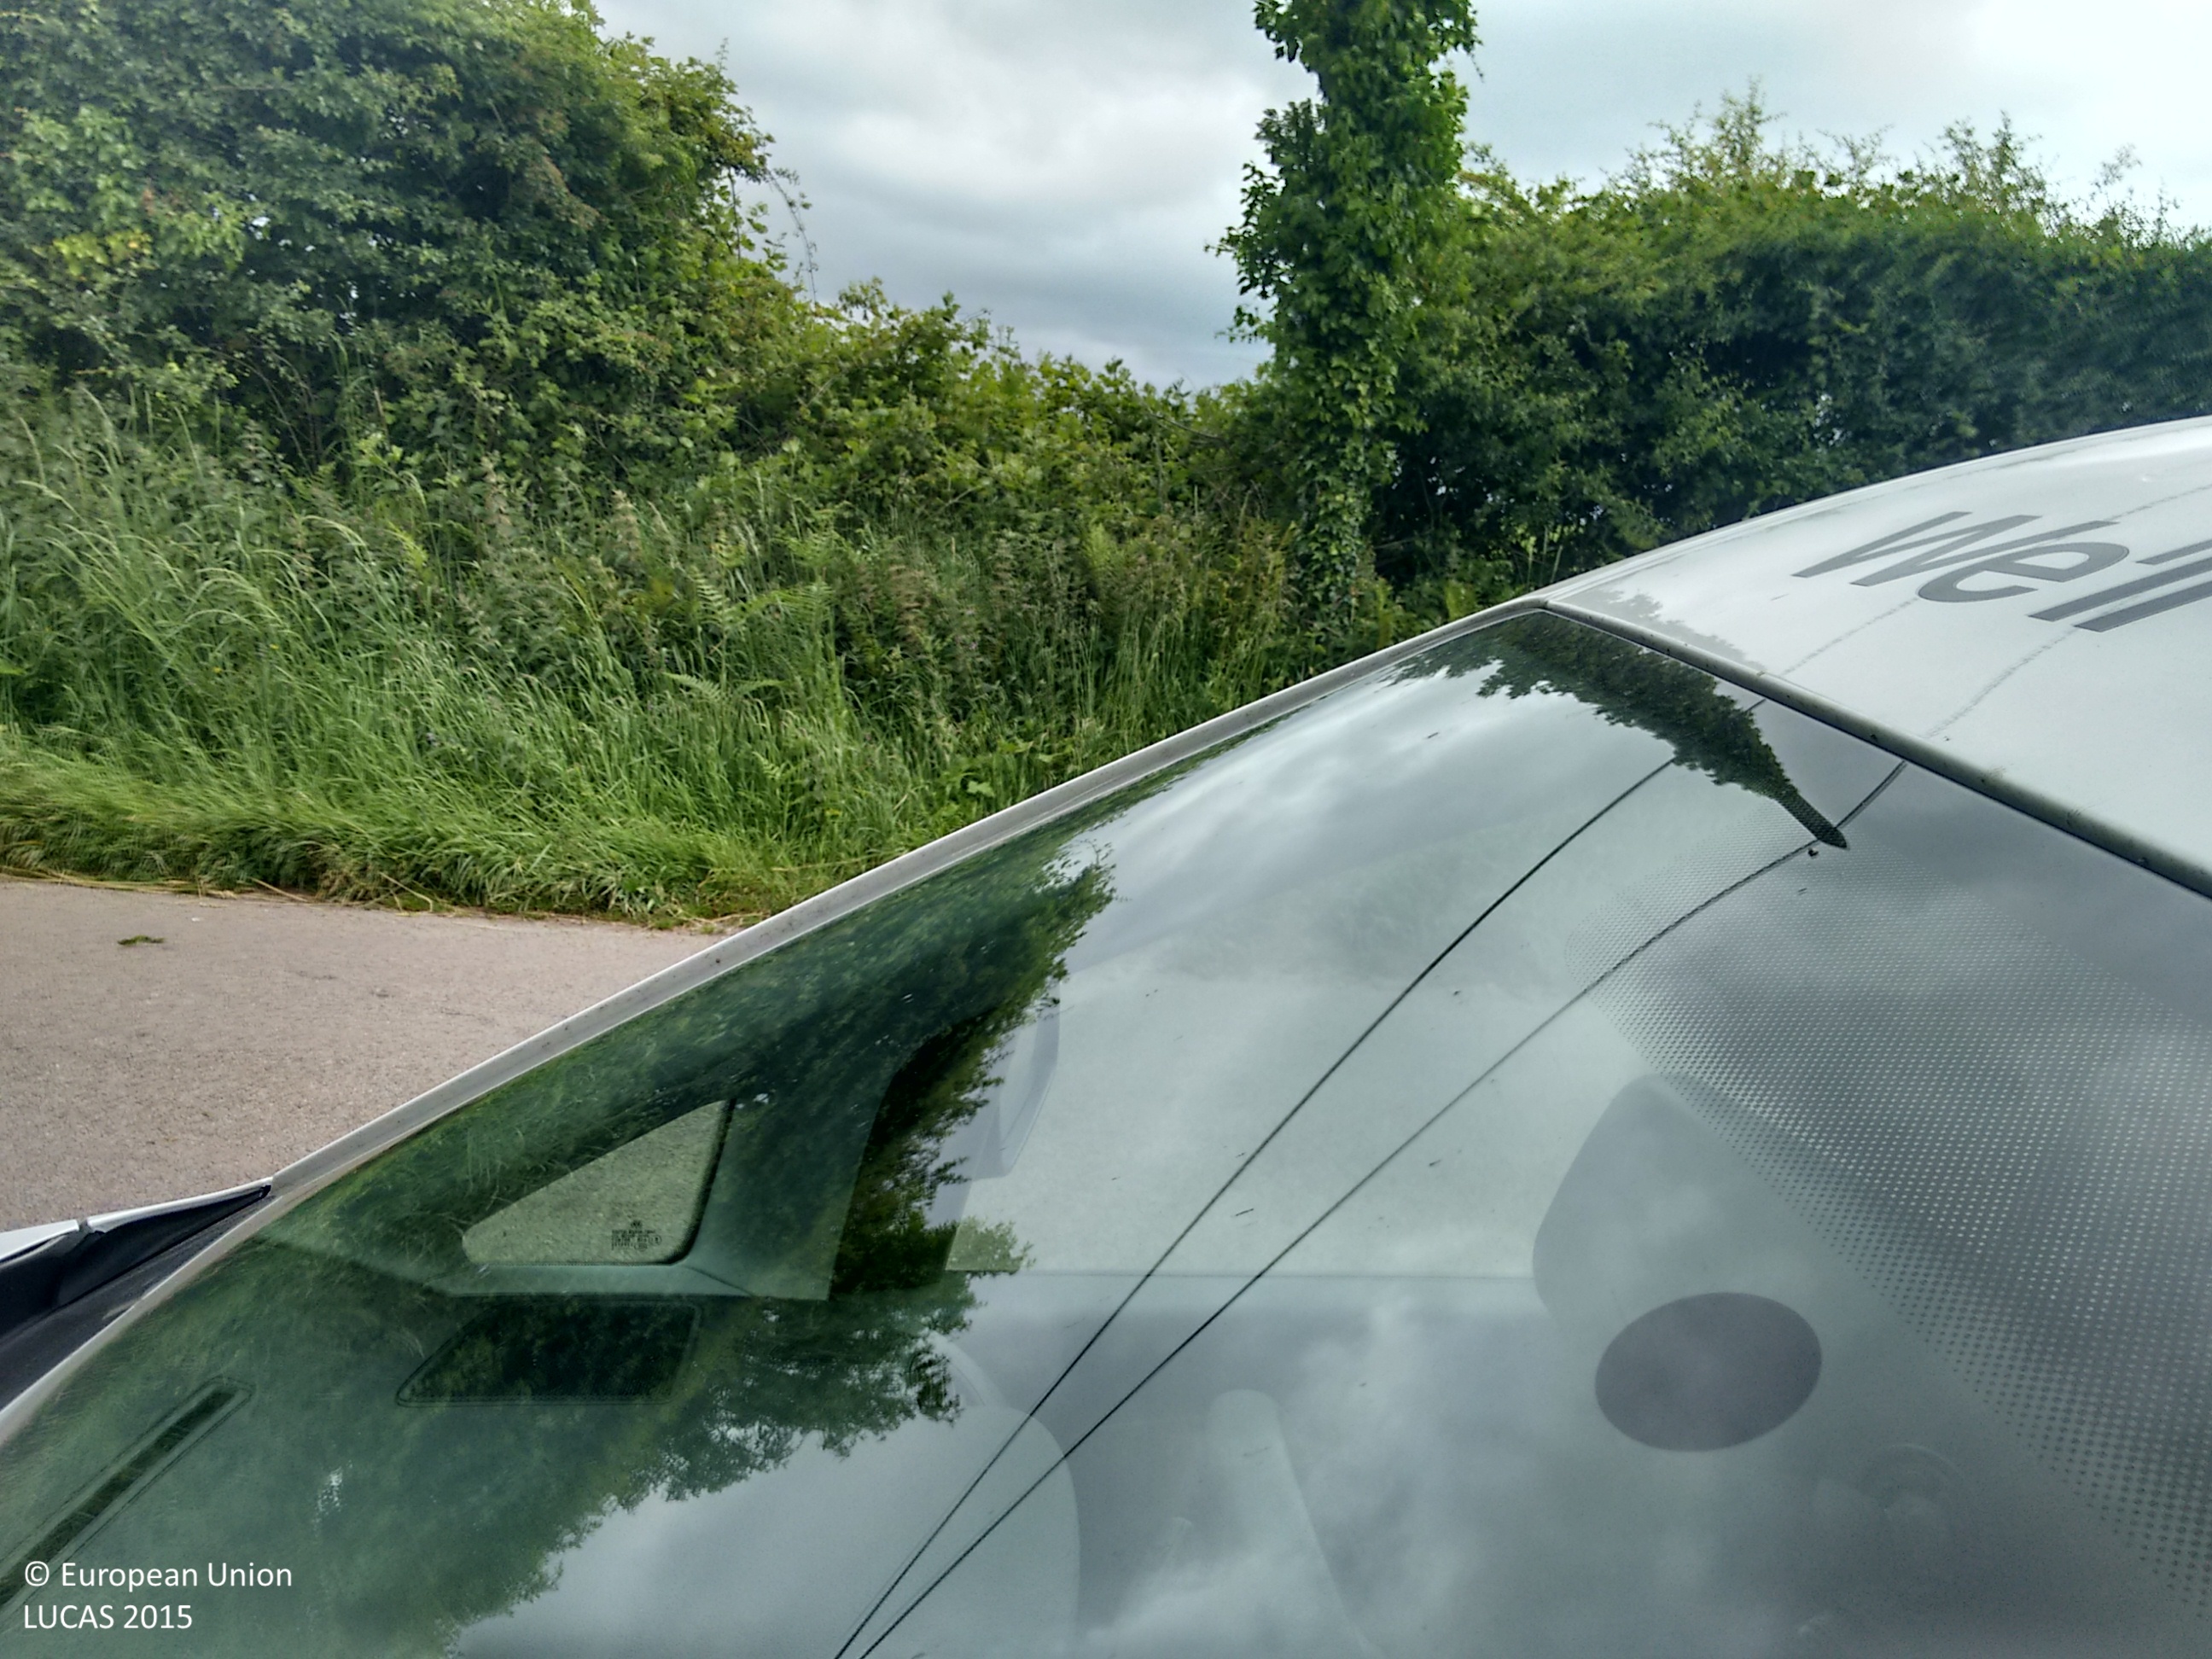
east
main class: Grassland
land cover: Grassland without tree/shrub cover
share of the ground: > 75 %
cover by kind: herbaceous plants 100 %
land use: Agriculture (excluding fallow land and kitchen gardens)
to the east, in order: Grassland without tree/shrub cover; Fences; Abandoned hedges; Ditches and canals; Grass margins; Paved roads, cycling and walking lanes; Electric lines; Abandoned hedges; Fences; Grassland without tree/shrub cover; Electric lines; Grassland without tree/shrub cover
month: June
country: IE
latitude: 52.0004
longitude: -8.1107
